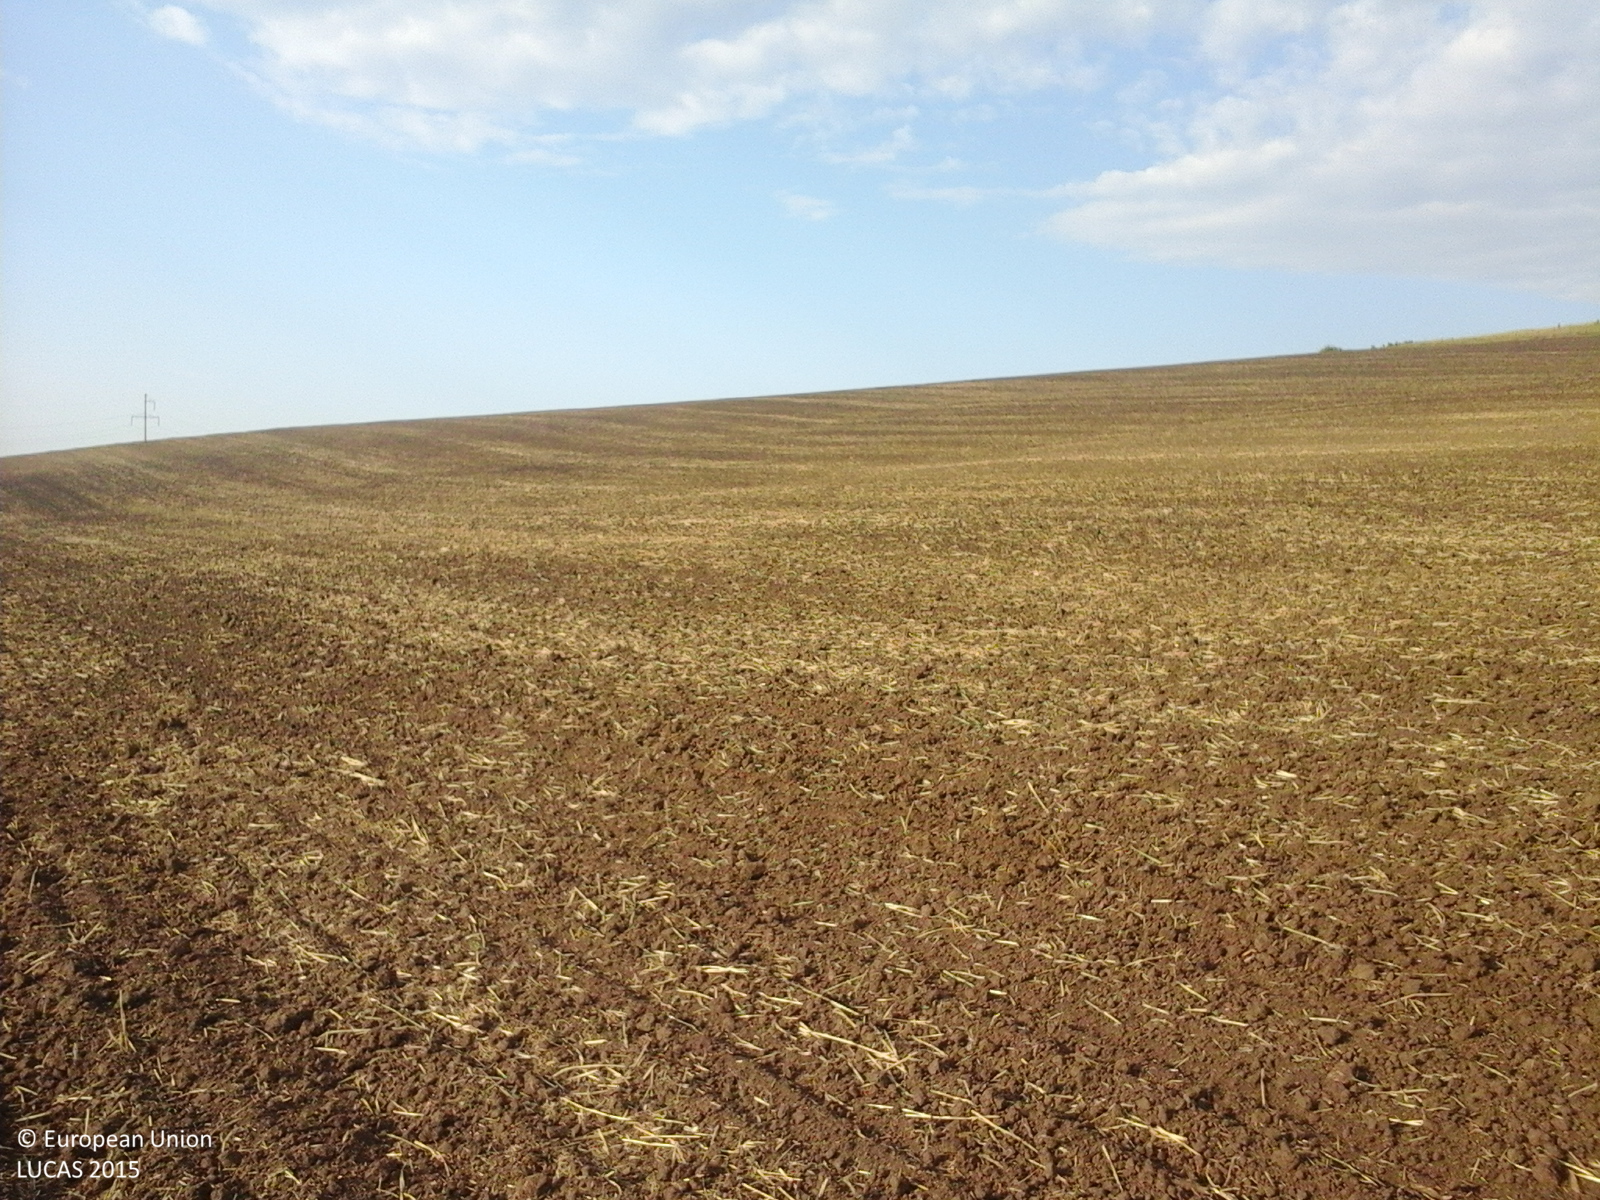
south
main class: Cropland
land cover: Durum wheat
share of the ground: > 75 %
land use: Agriculture (excluding fallow land and kitchen gardens)
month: July
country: RO
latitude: 46.4092
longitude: 27.7980
